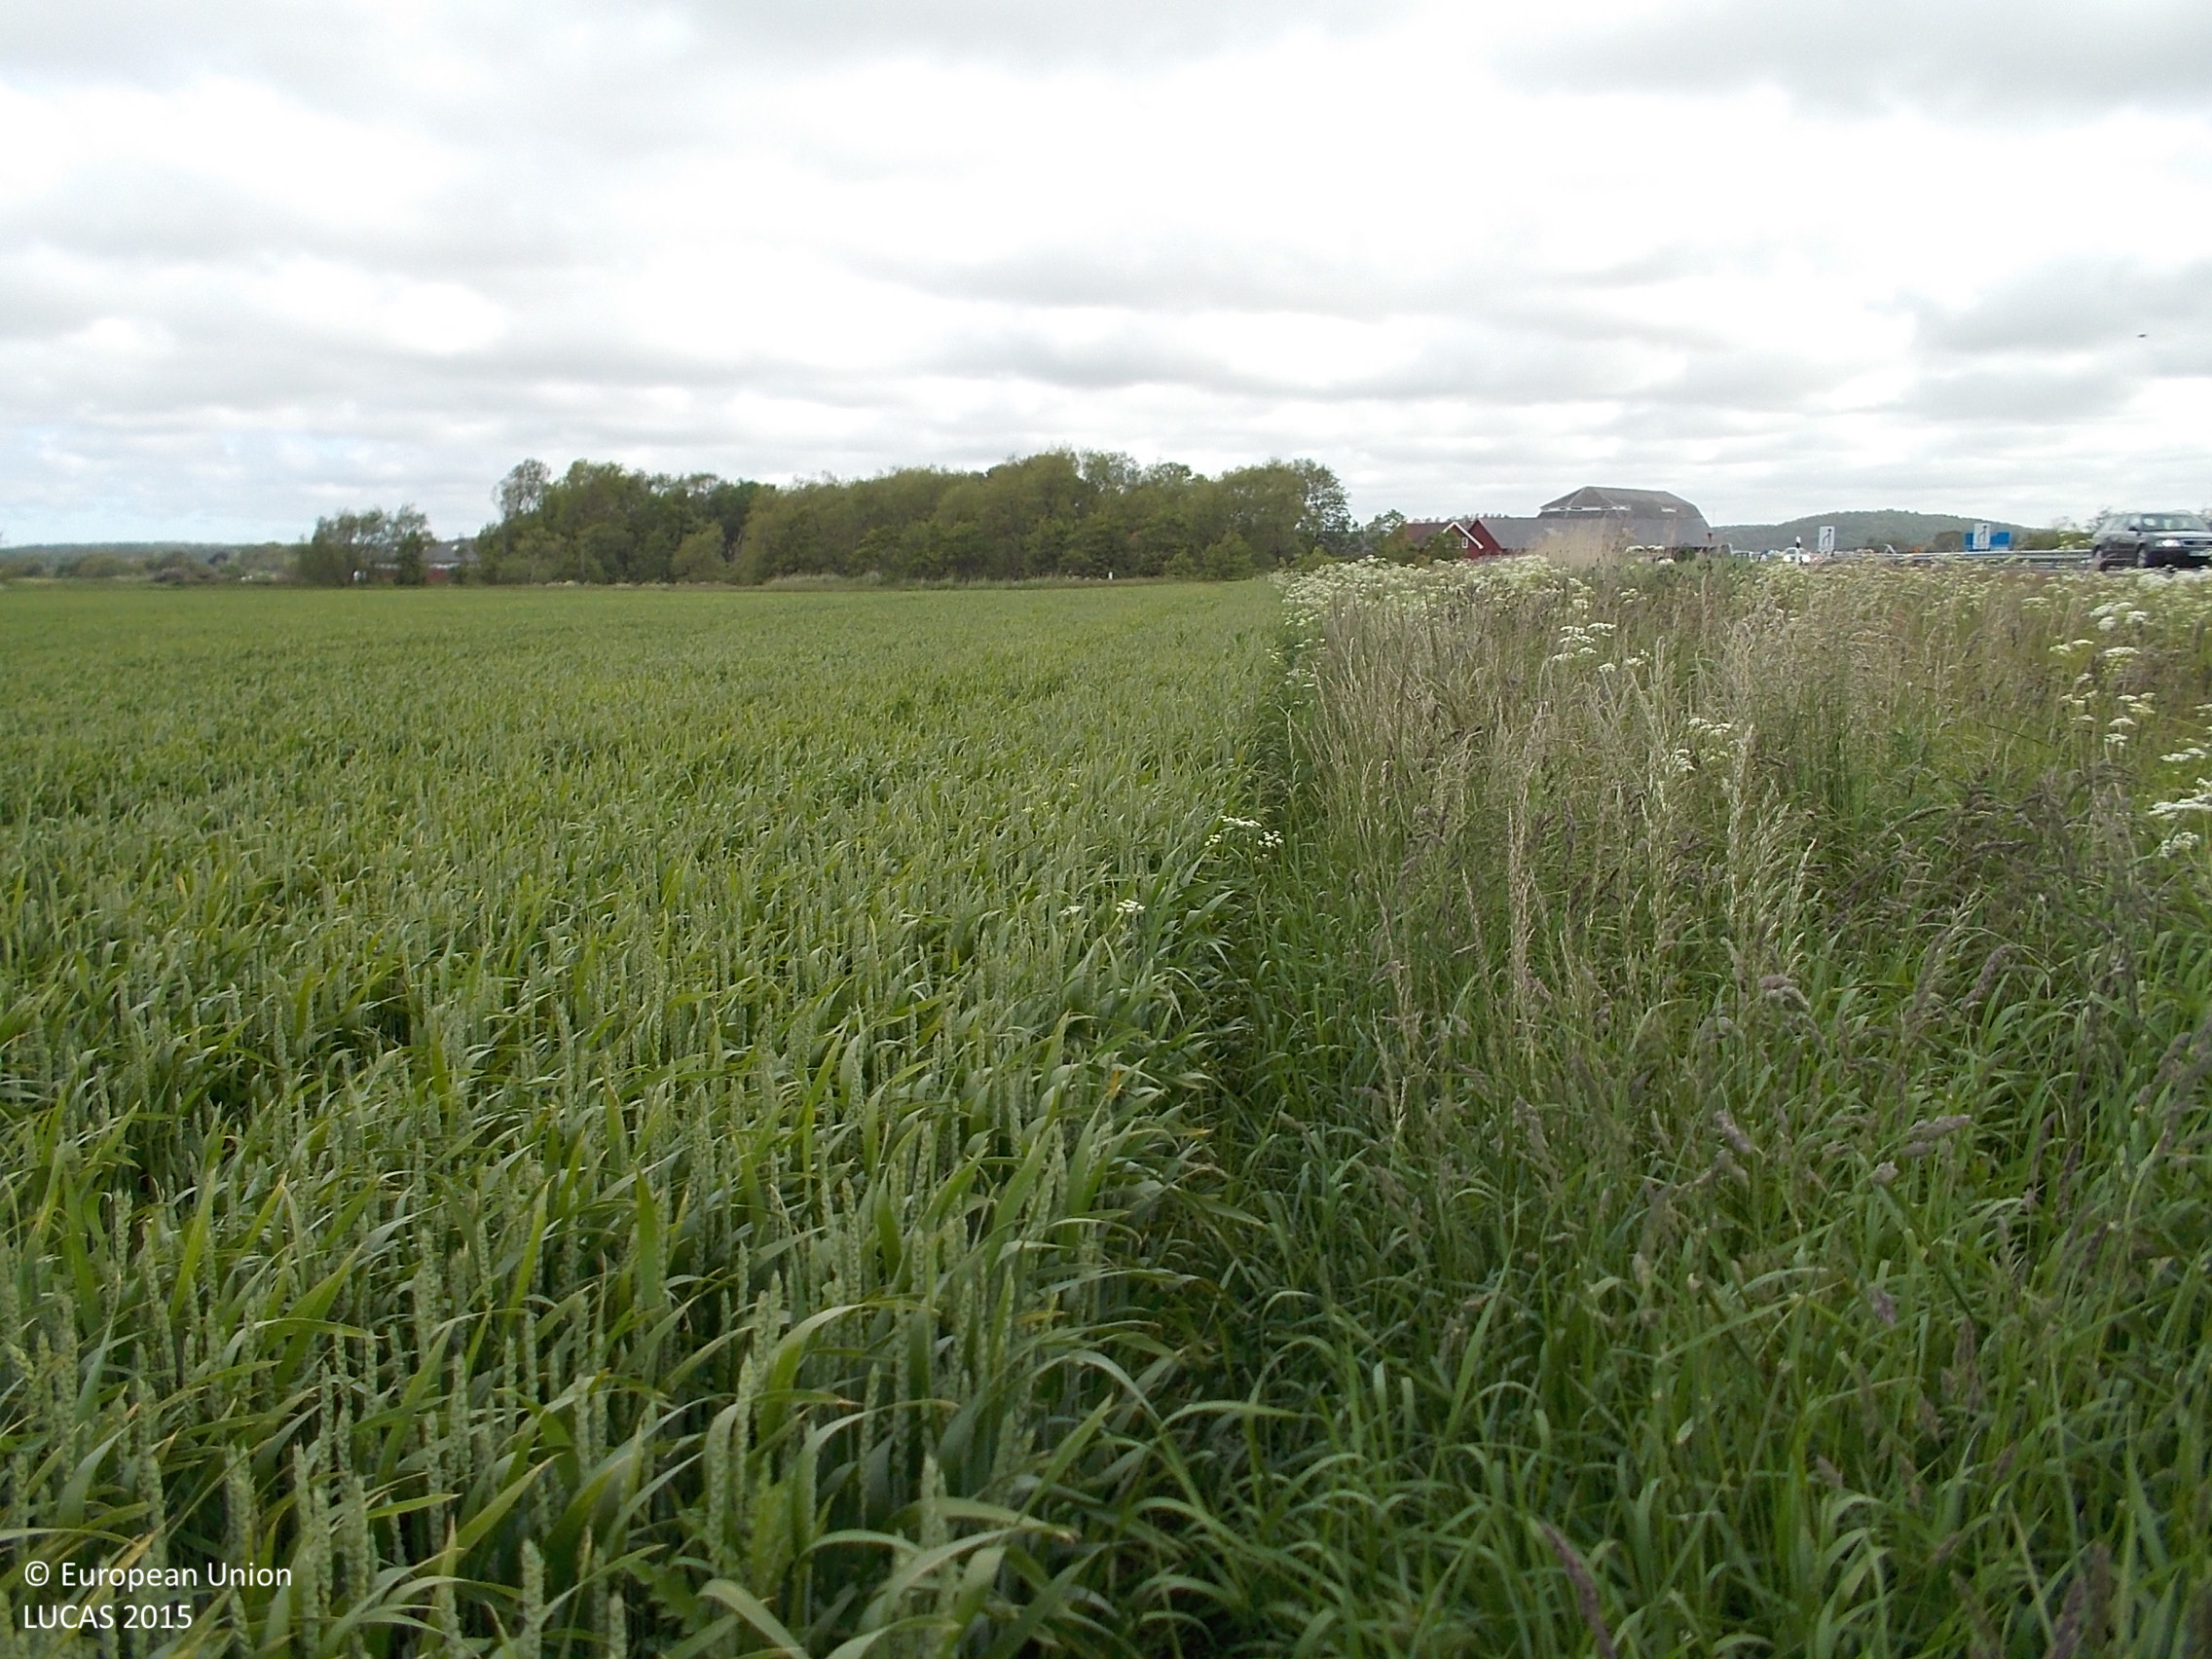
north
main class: Cropland
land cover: Common wheat
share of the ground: > 75 %
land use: Agriculture (excluding fallow land and kitchen gardens)
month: June
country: SE
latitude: 57.1391
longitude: 12.2607
